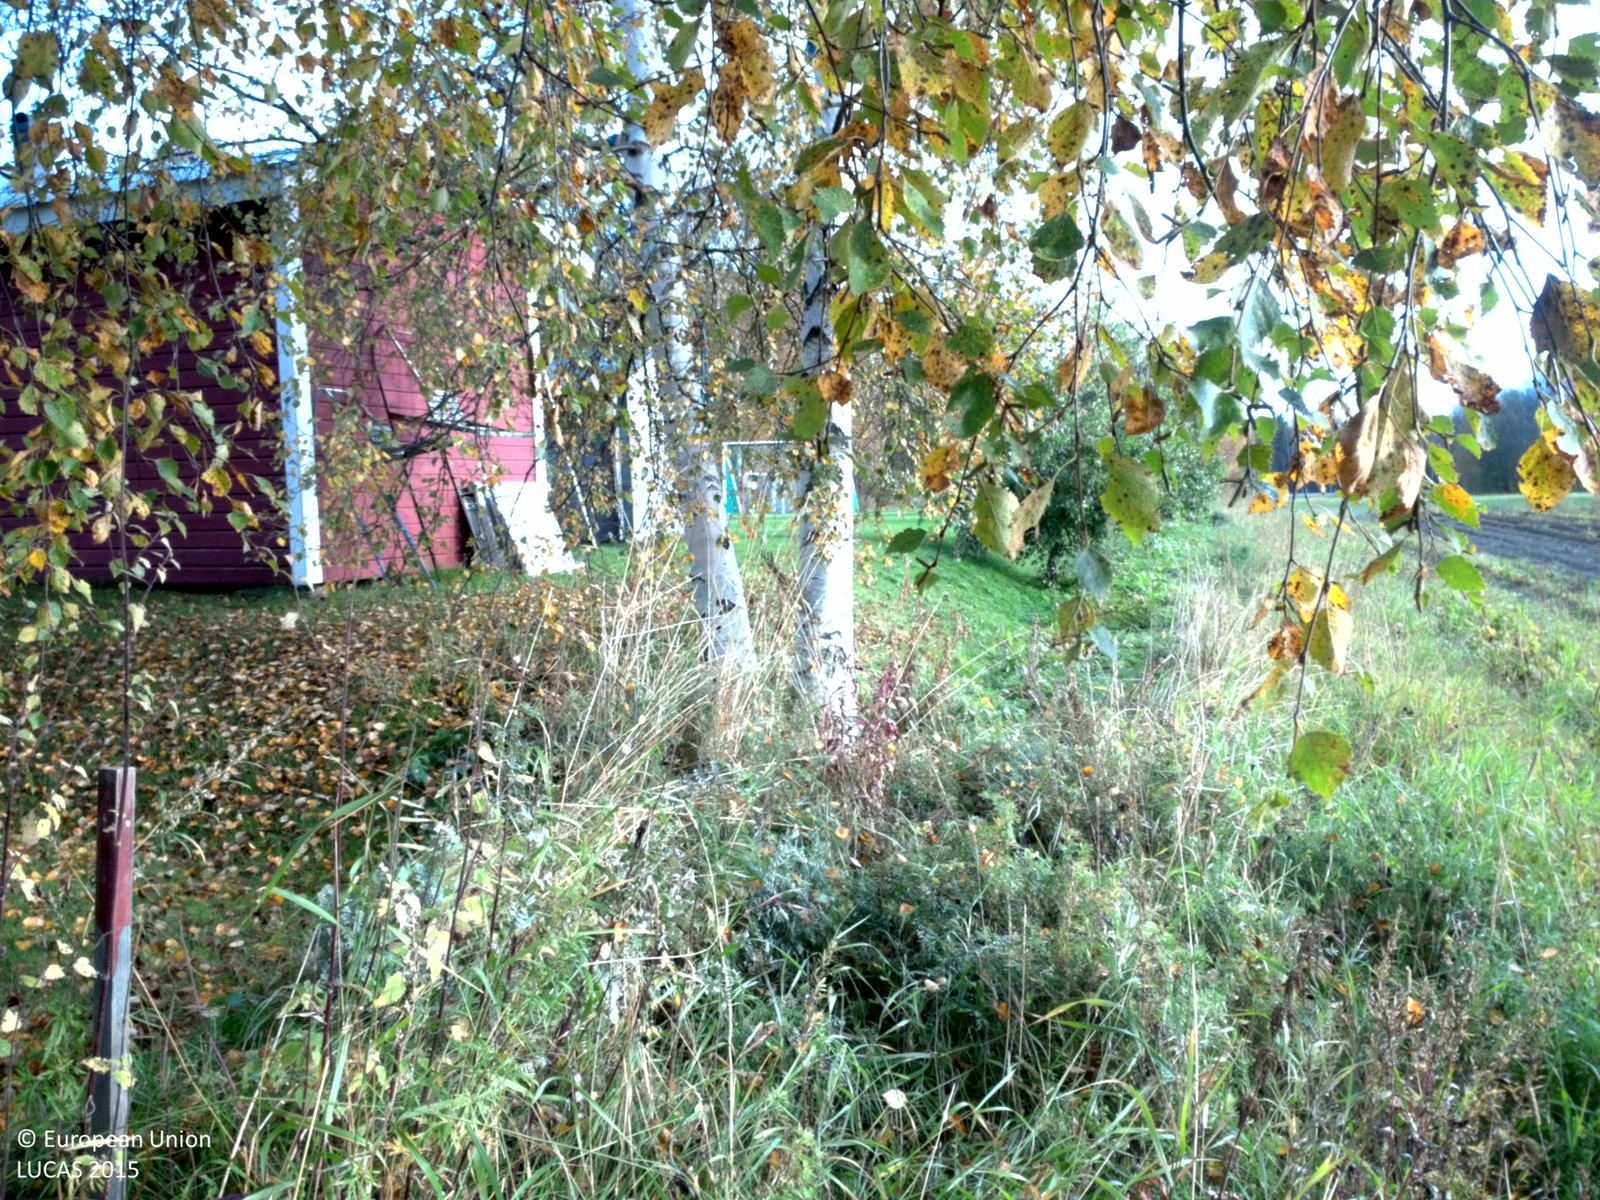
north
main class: Grassland
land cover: Grassland without tree/shrub cover
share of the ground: > 75 %
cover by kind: herbaceous plants 100 %
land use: Residential
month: September
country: SE
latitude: 65.6695
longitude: 21.9182
